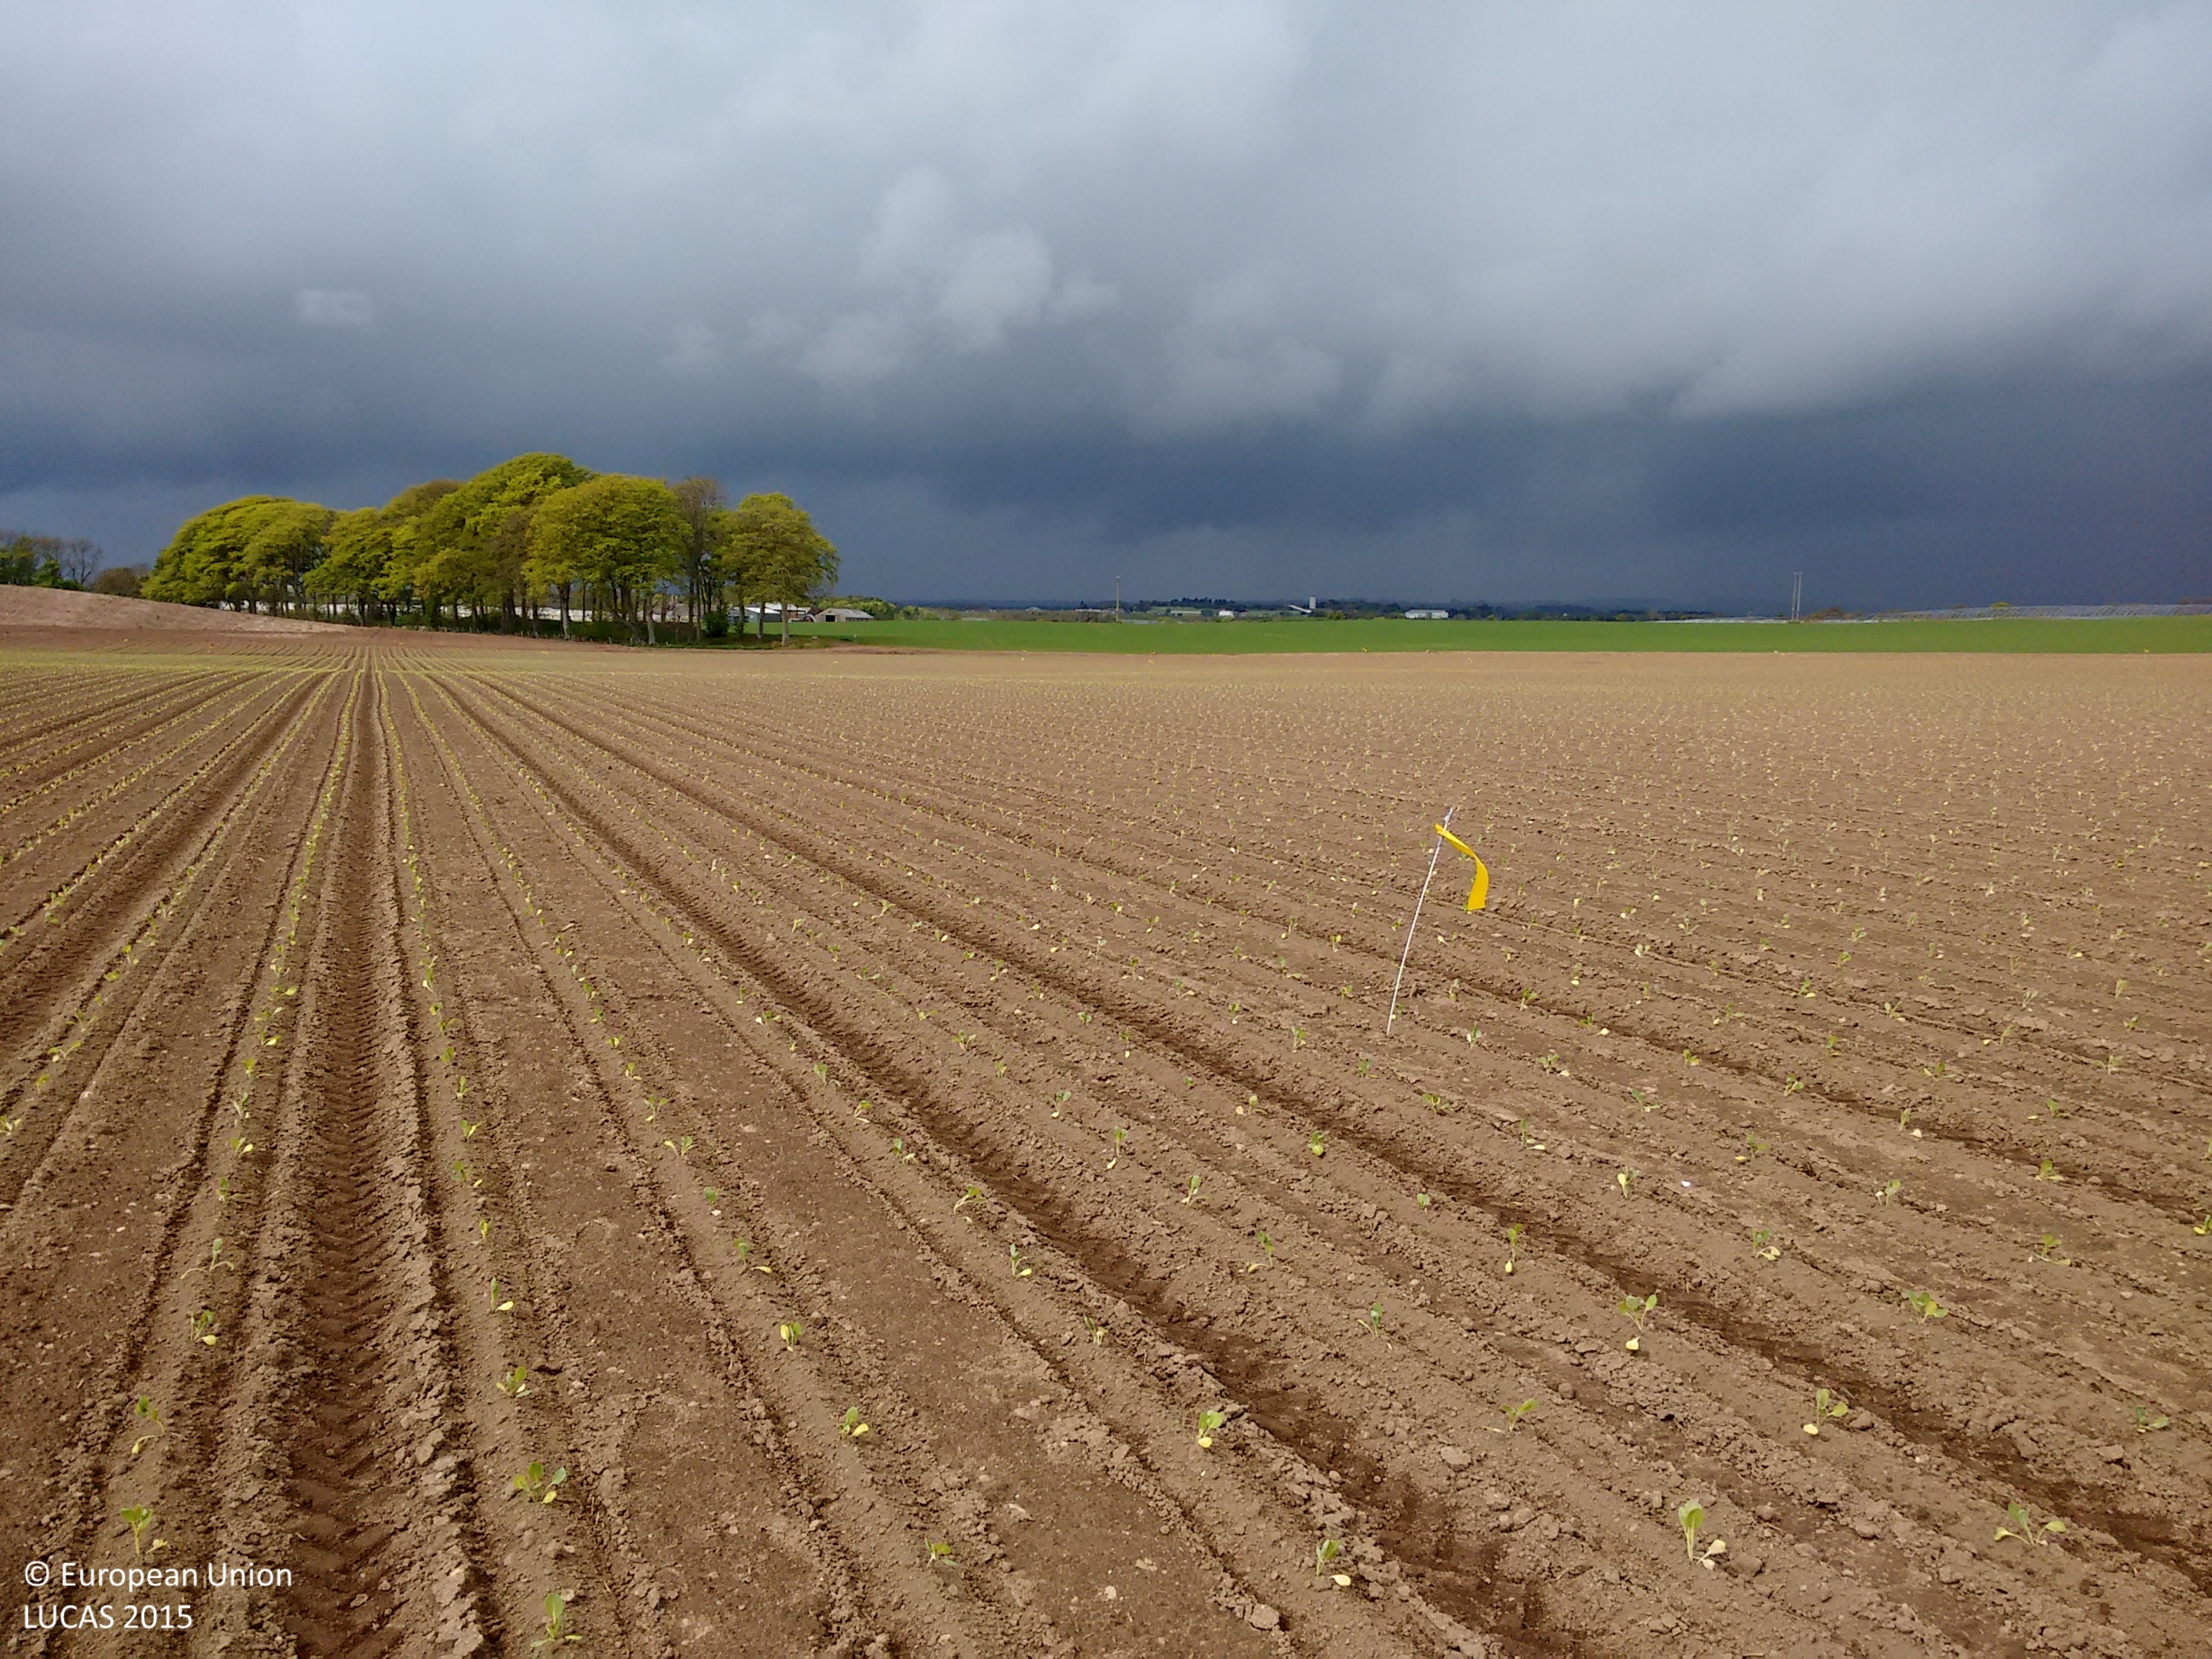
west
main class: Cropland
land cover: Other fresh vegetables
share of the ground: < 10 %
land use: Agriculture (excluding fallow land and kitchen gardens)
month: May
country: GB
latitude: 56.5862
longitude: -2.5793
